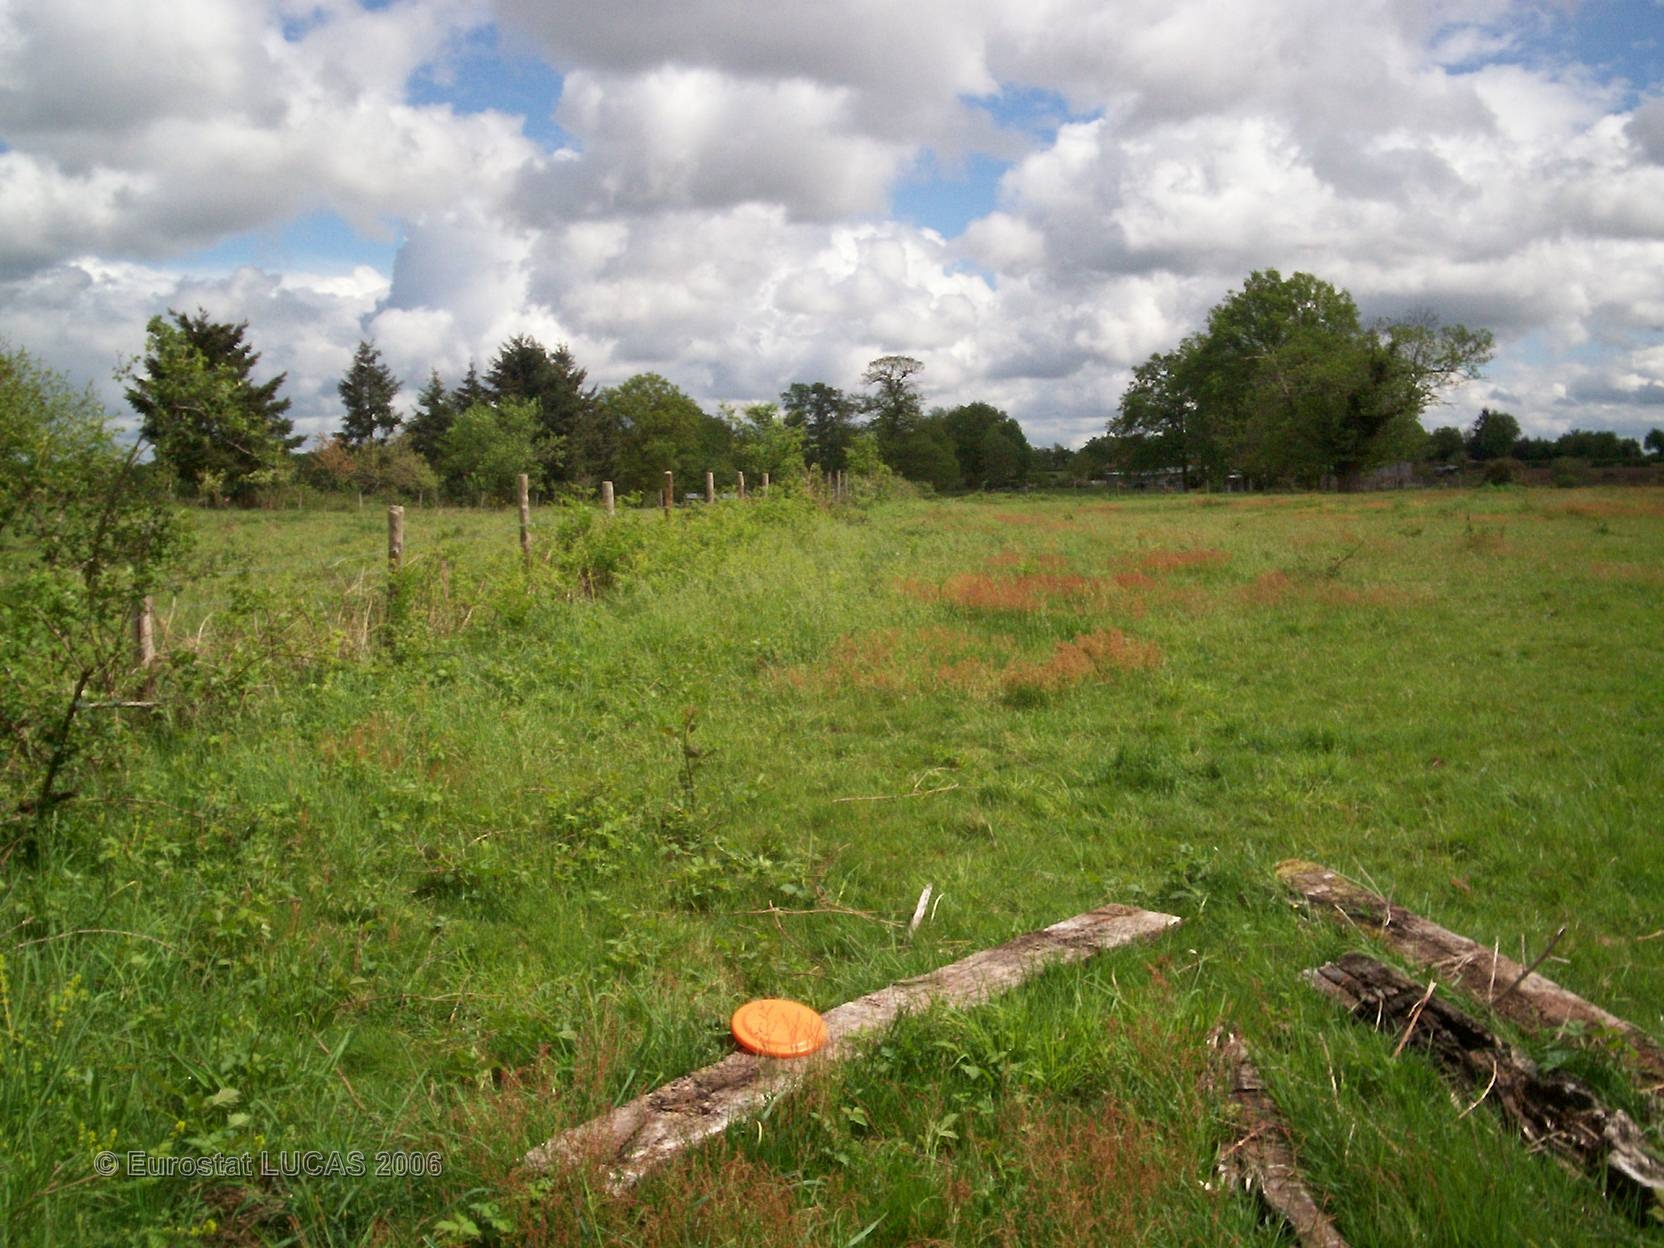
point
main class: Grassland
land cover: Grassland without tree/shrub cover
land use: Agriculture (excluding fallow land and kitchen gardens)
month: May
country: FR
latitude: 45.9817
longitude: 0.4973
